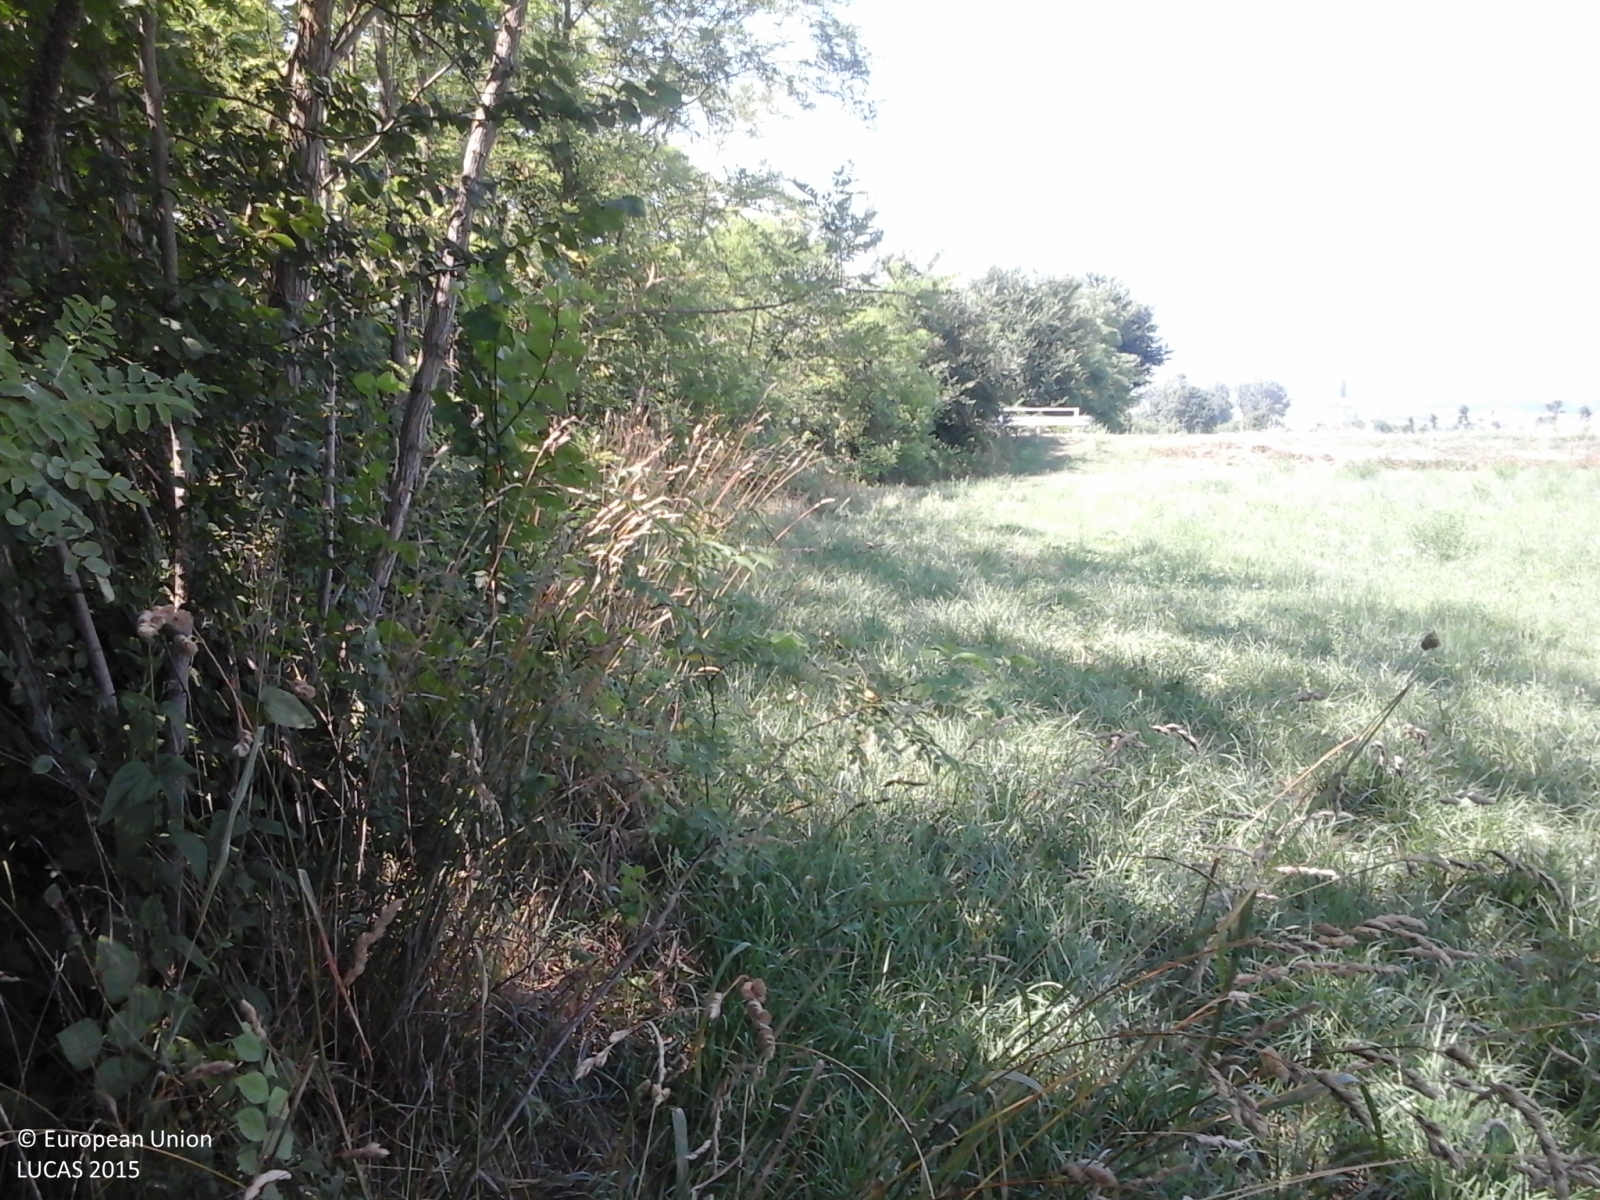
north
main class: Grassland
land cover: Grassland without tree/shrub cover
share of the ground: > 75 %
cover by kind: herbaceous plants 100 %
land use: Agriculture (excluding fallow land and kitchen gardens)
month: June
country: IT
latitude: 45.0025
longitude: 8.2145
